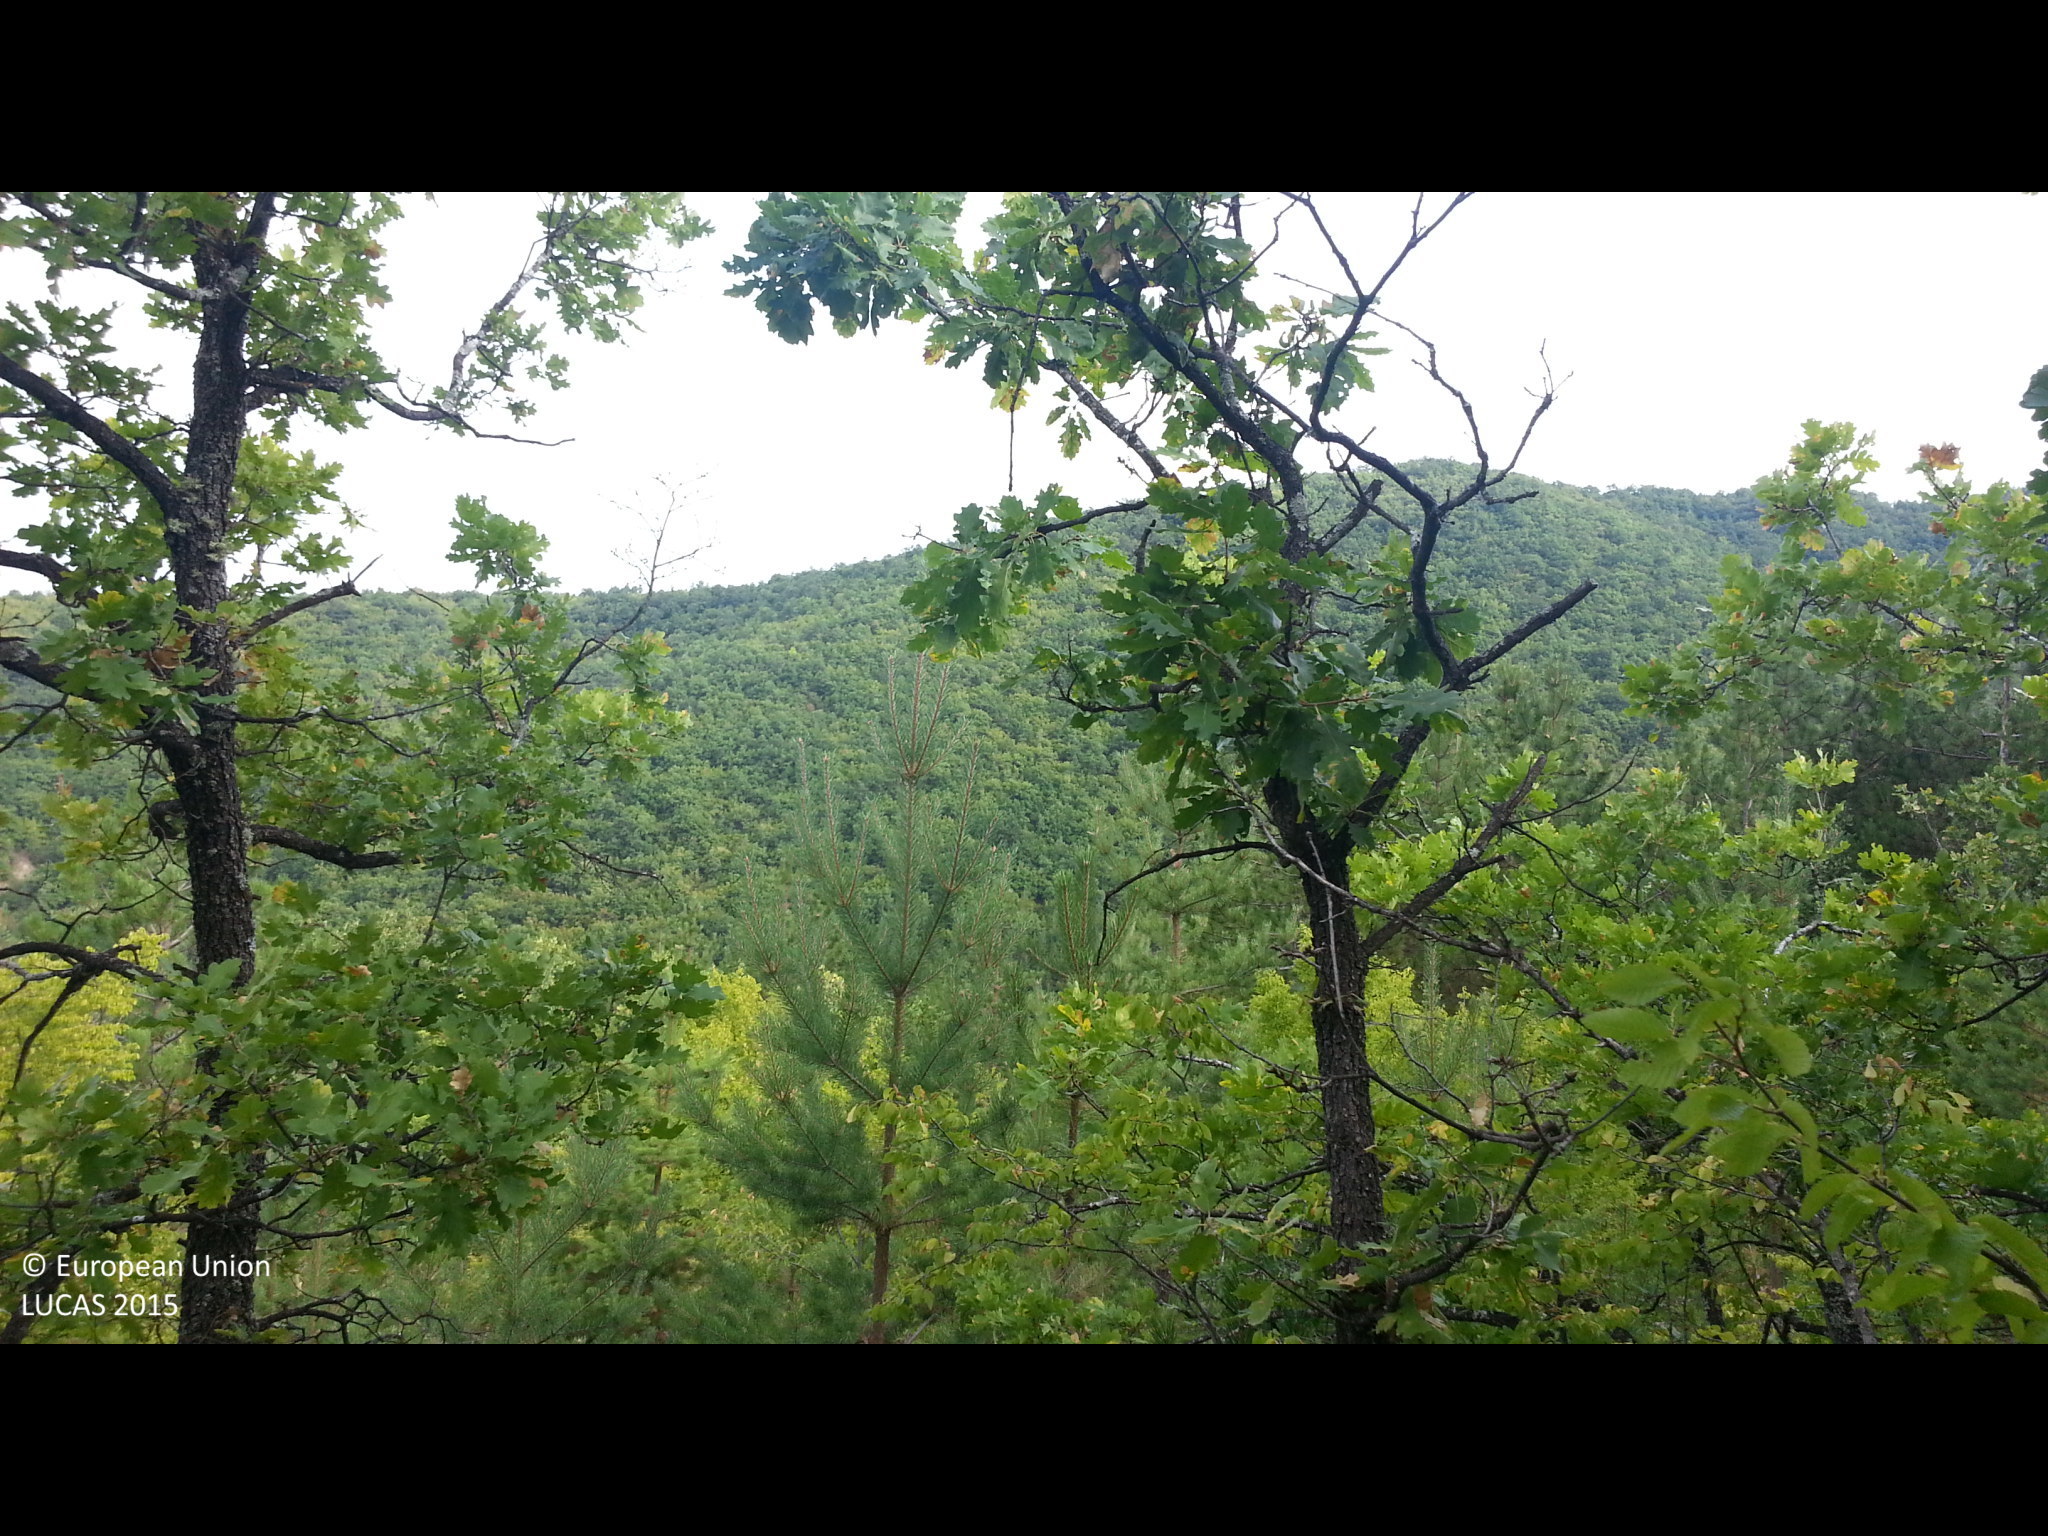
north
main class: Woodland
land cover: Broadleaved woodland
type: mesophytic deciduous forest
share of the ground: > 75 %
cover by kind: broadleaved forest trees 90 %, shrubs 10 %
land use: Forestry
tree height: > 5 m
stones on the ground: > 50 %
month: August
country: BG
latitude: 42.3487
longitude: 22.8065
